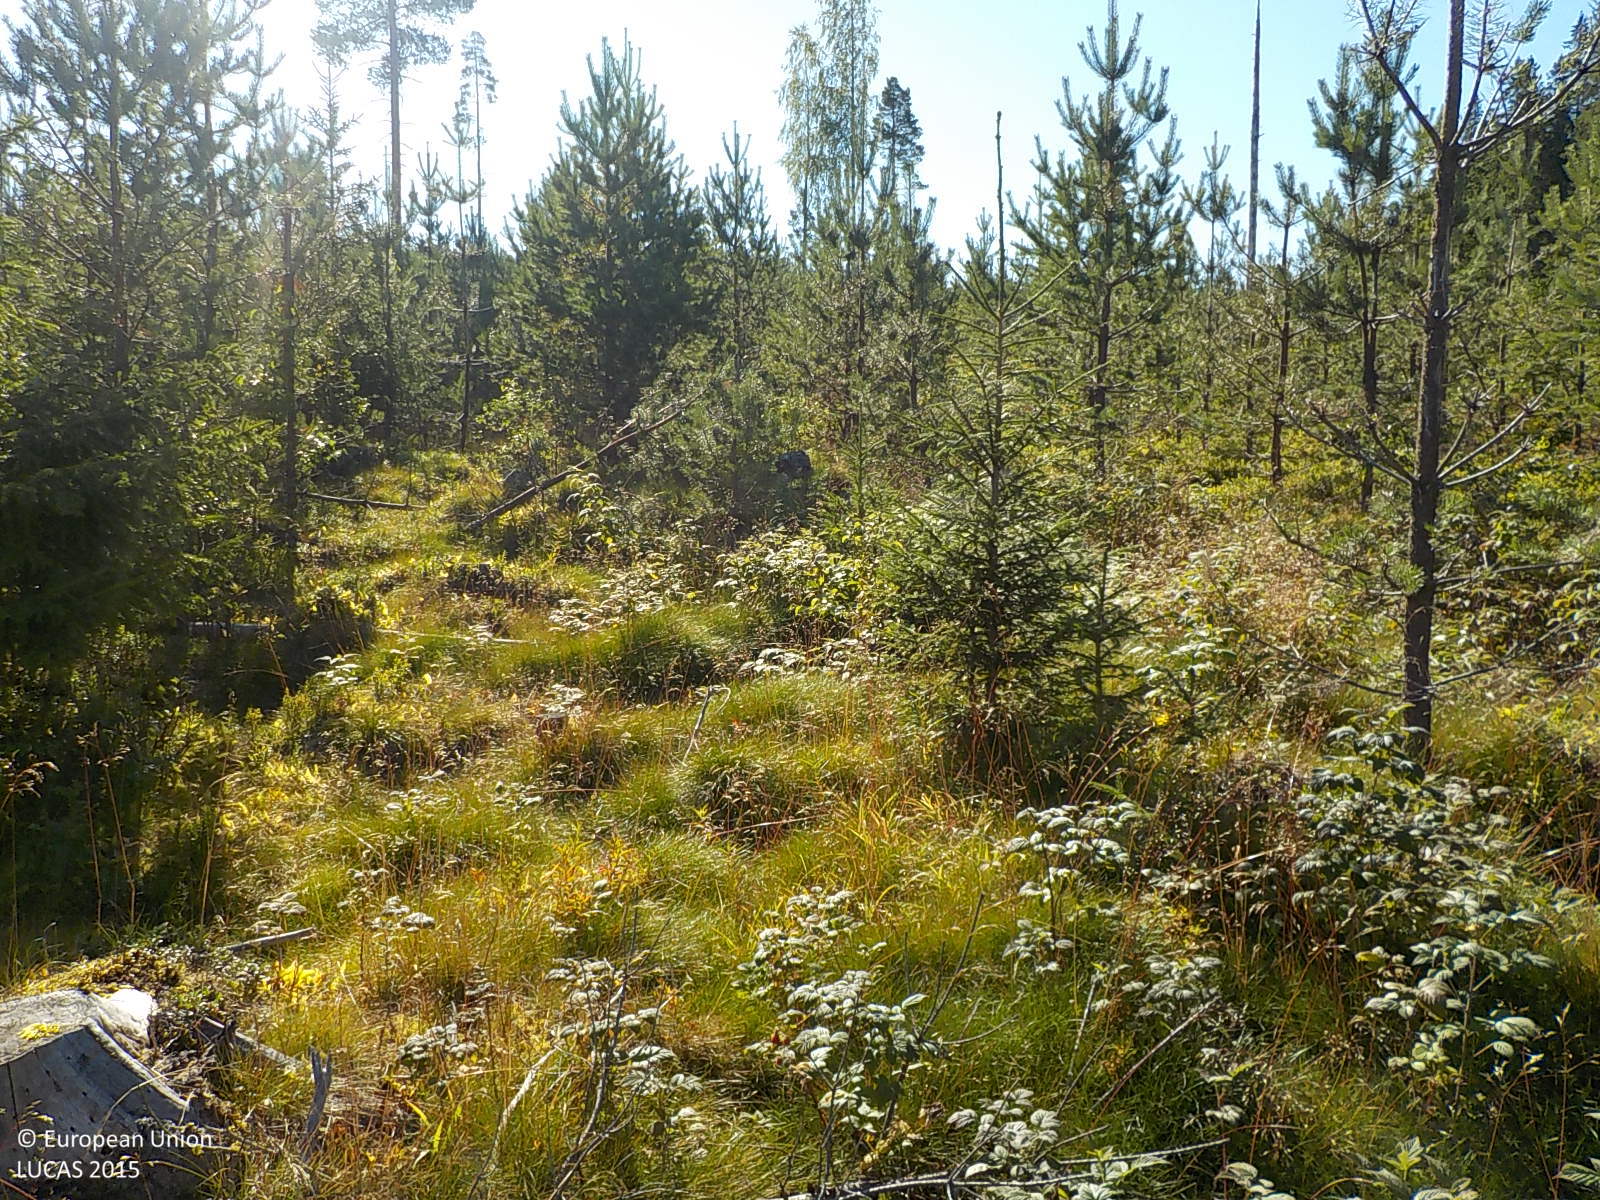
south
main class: Woodland
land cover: Pine dominated coniferous woodland
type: boreal forest
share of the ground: 50 - 75 %
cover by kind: coniferous forest trees 60 %, shrubs 40 %
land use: Forestry
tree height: < 5 m
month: August
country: SE
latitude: 63.4904
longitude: 18.6314
